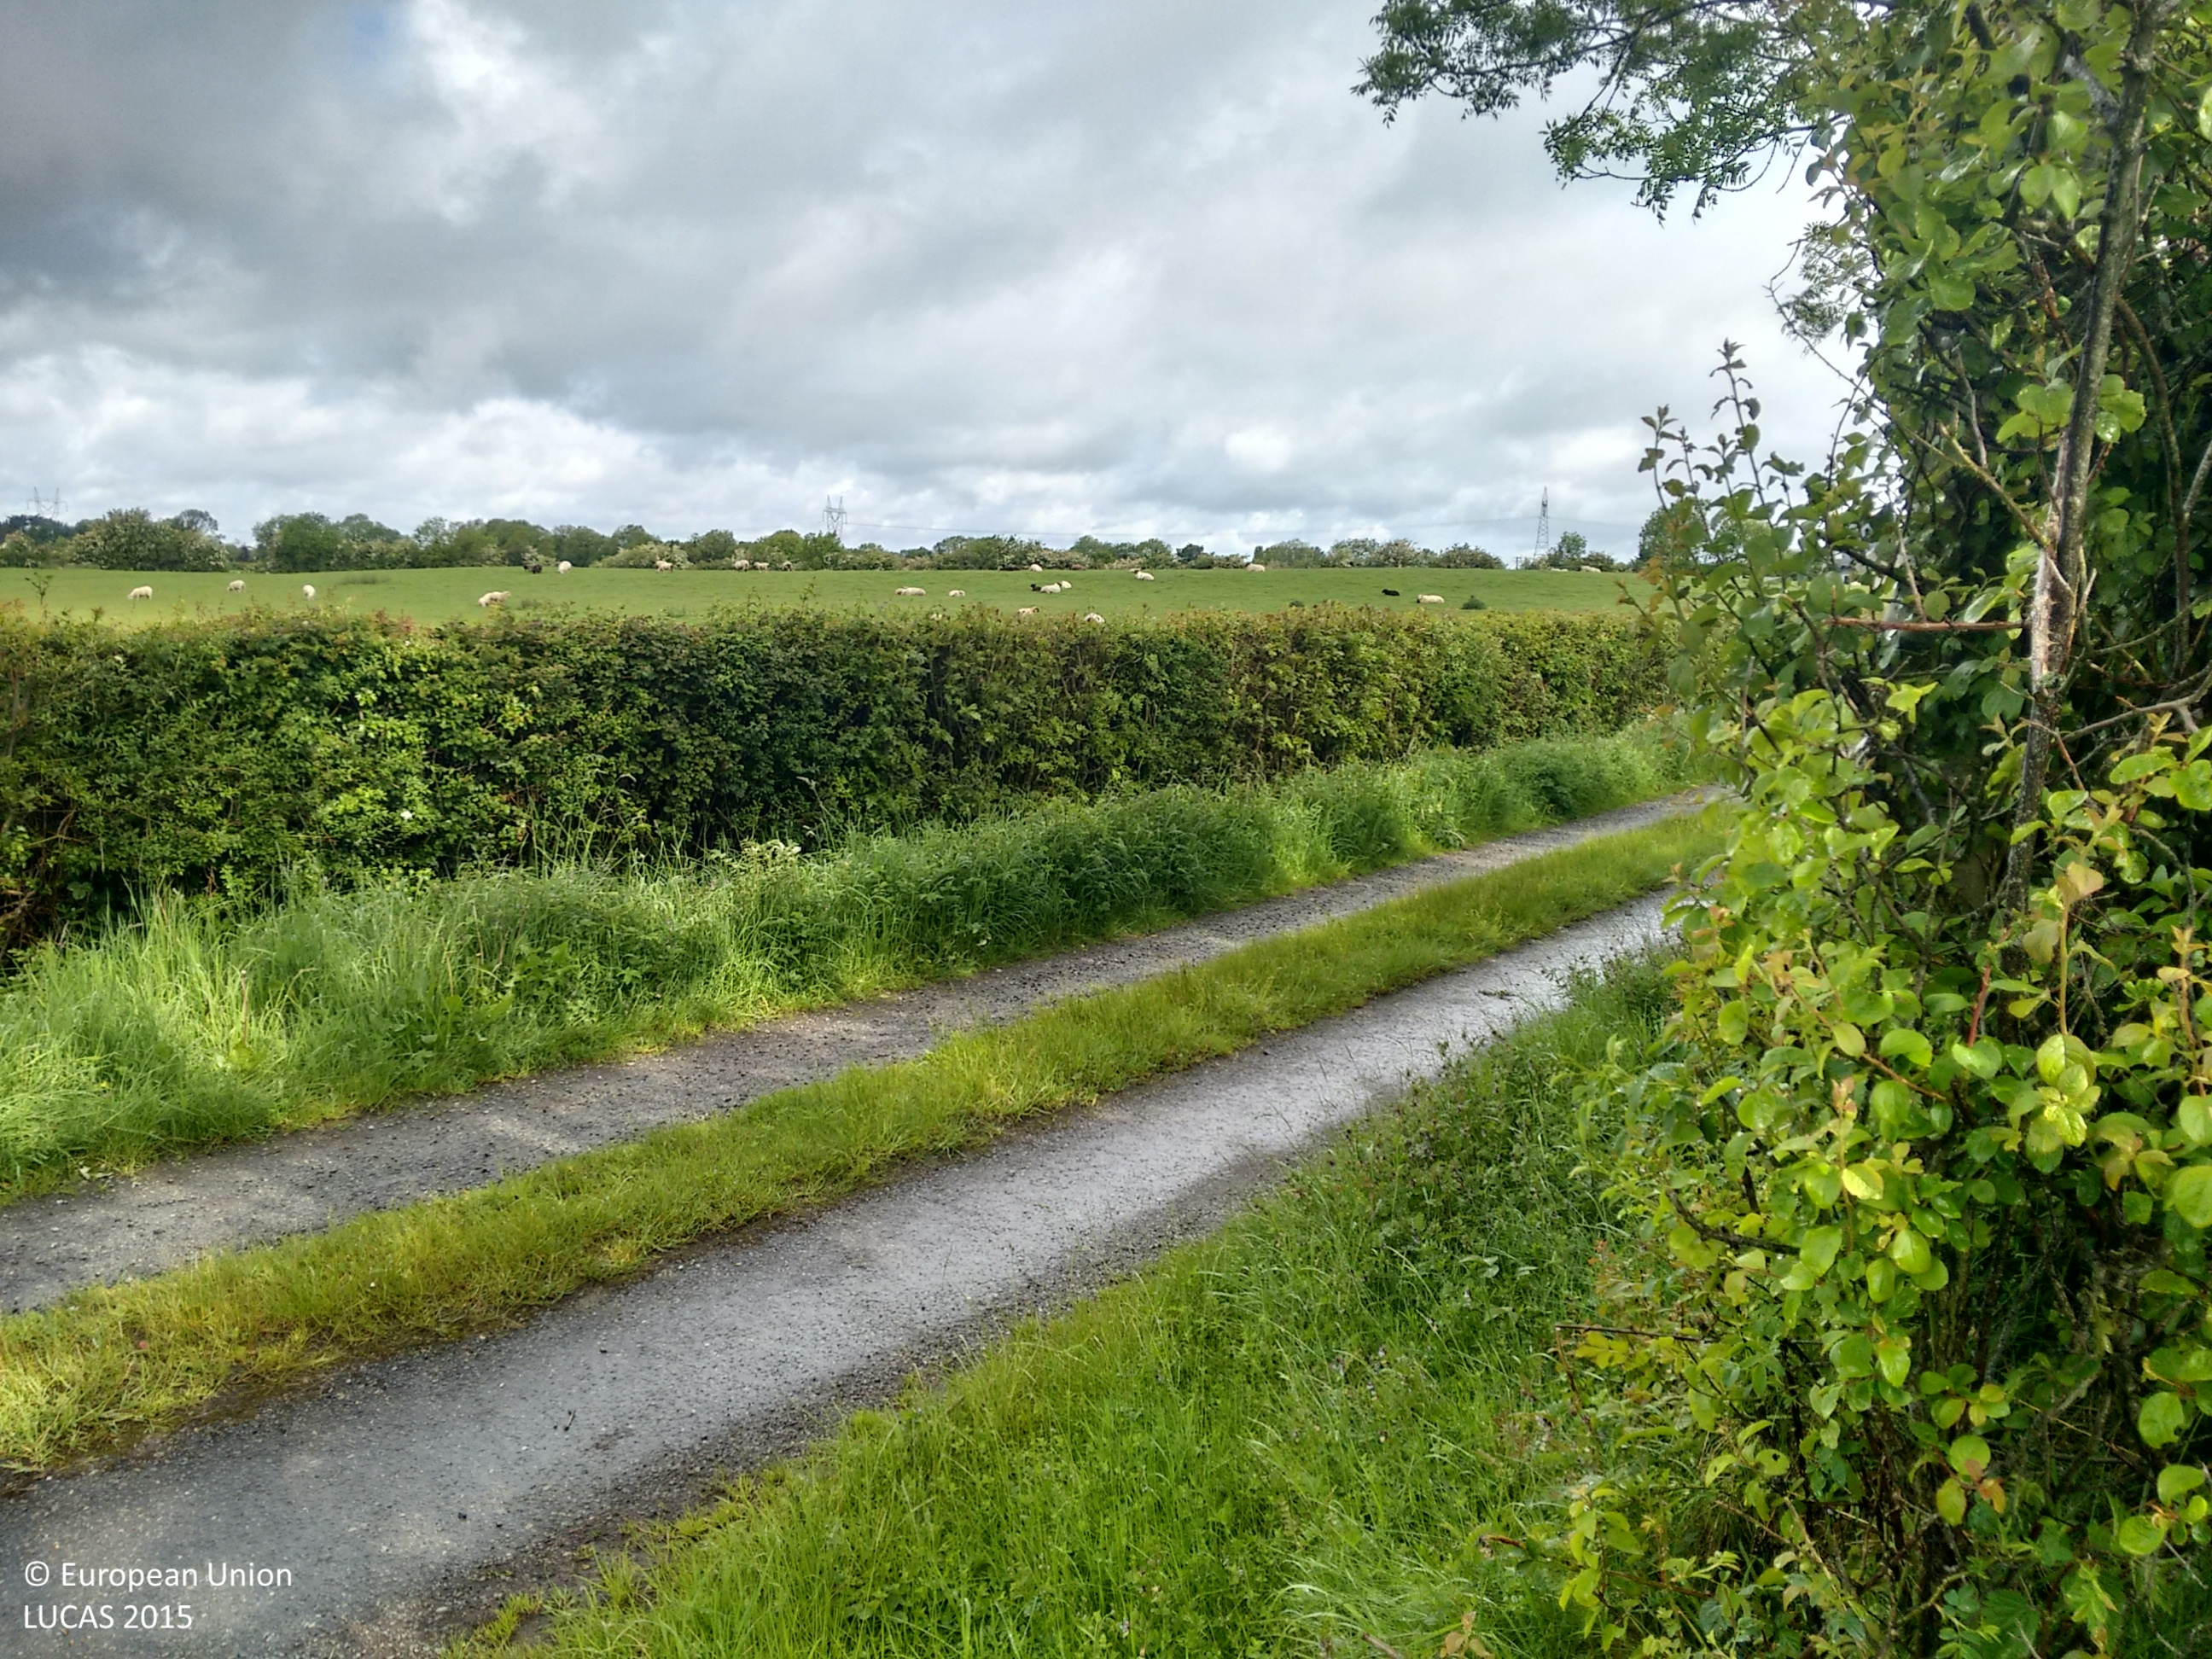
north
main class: Grassland
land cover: Grassland without tree/shrub cover
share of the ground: > 75 %
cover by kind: herbaceous plants 100 %
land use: Agriculture (excluding fallow land and kitchen gardens)
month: June
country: IE
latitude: 53.3961
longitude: -6.9073
